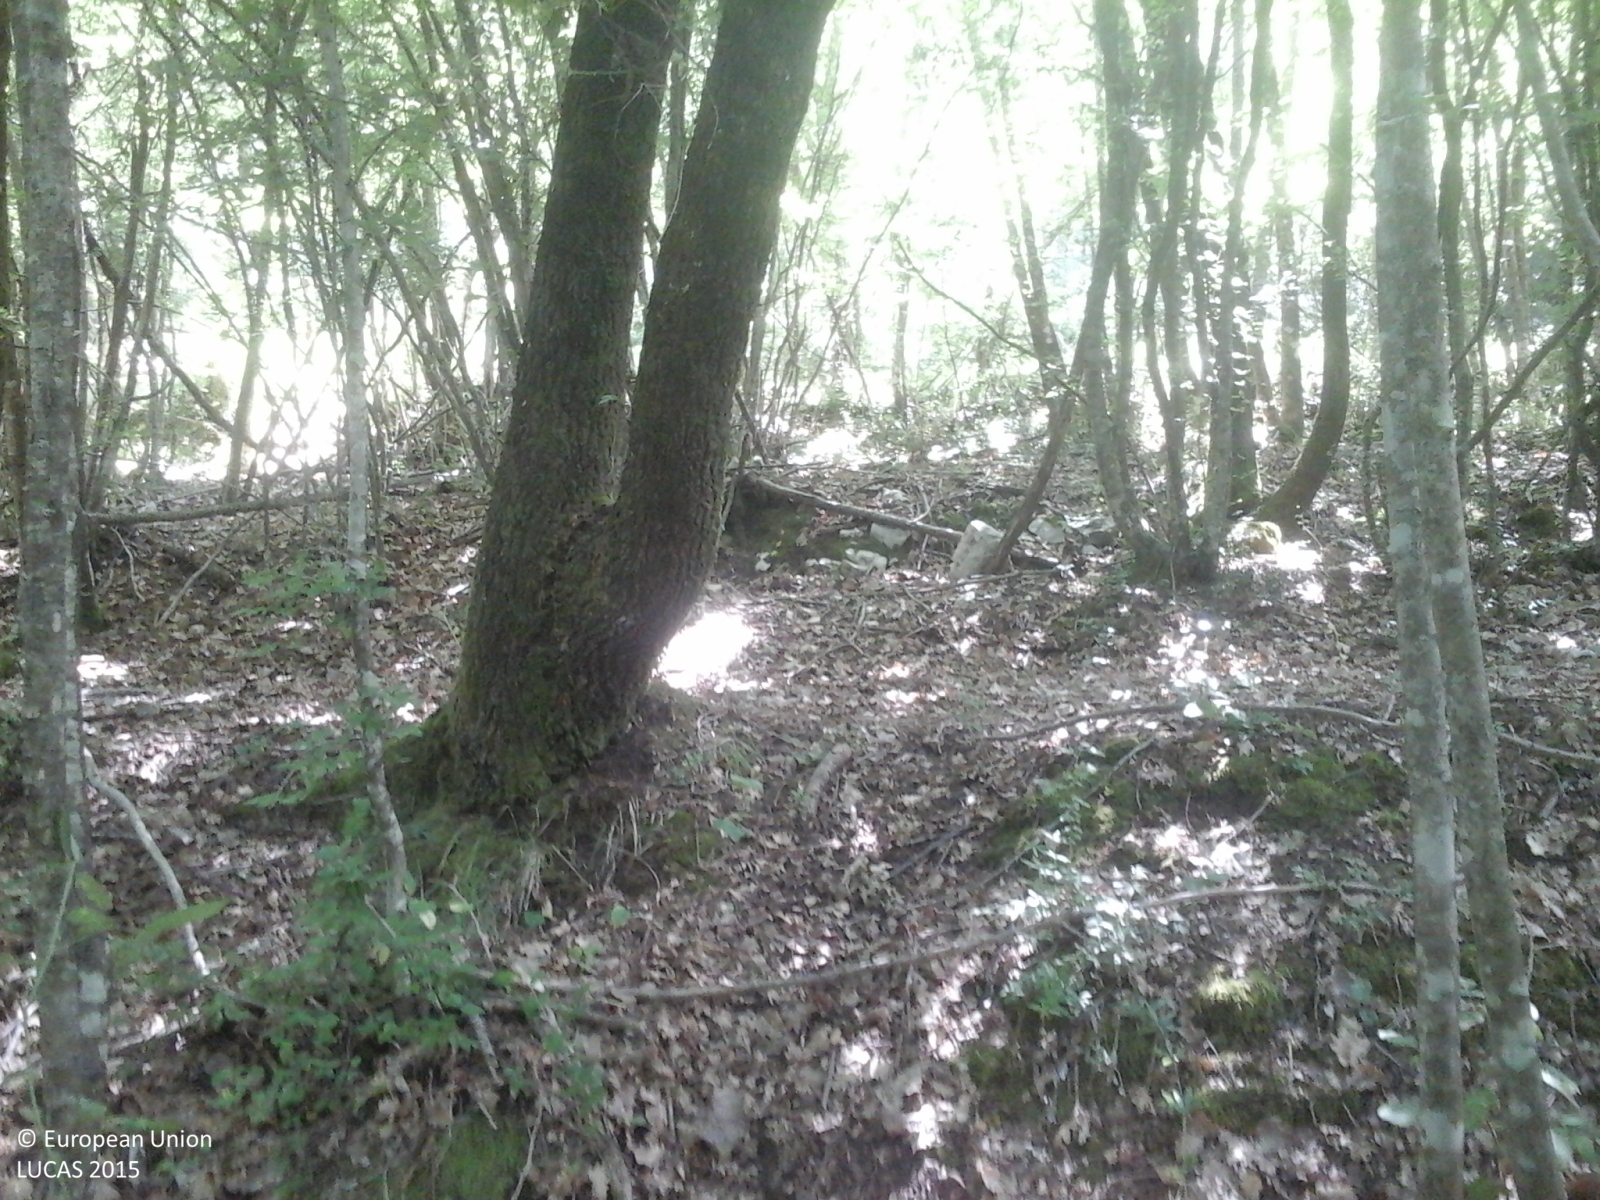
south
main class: Woodland
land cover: Broadleaved woodland
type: thermophilous deciduous forest
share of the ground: > 75 %
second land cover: Grassland without tree/shrub cover
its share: > 75 %
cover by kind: broadleaved forest trees 95 %, herbaceous plants 5 %
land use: Forestry
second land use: Agriculture (excluding fallow land and kitchen gardens)
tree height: > 5 m
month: June
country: IT
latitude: 41.5543
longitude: 13.2127
